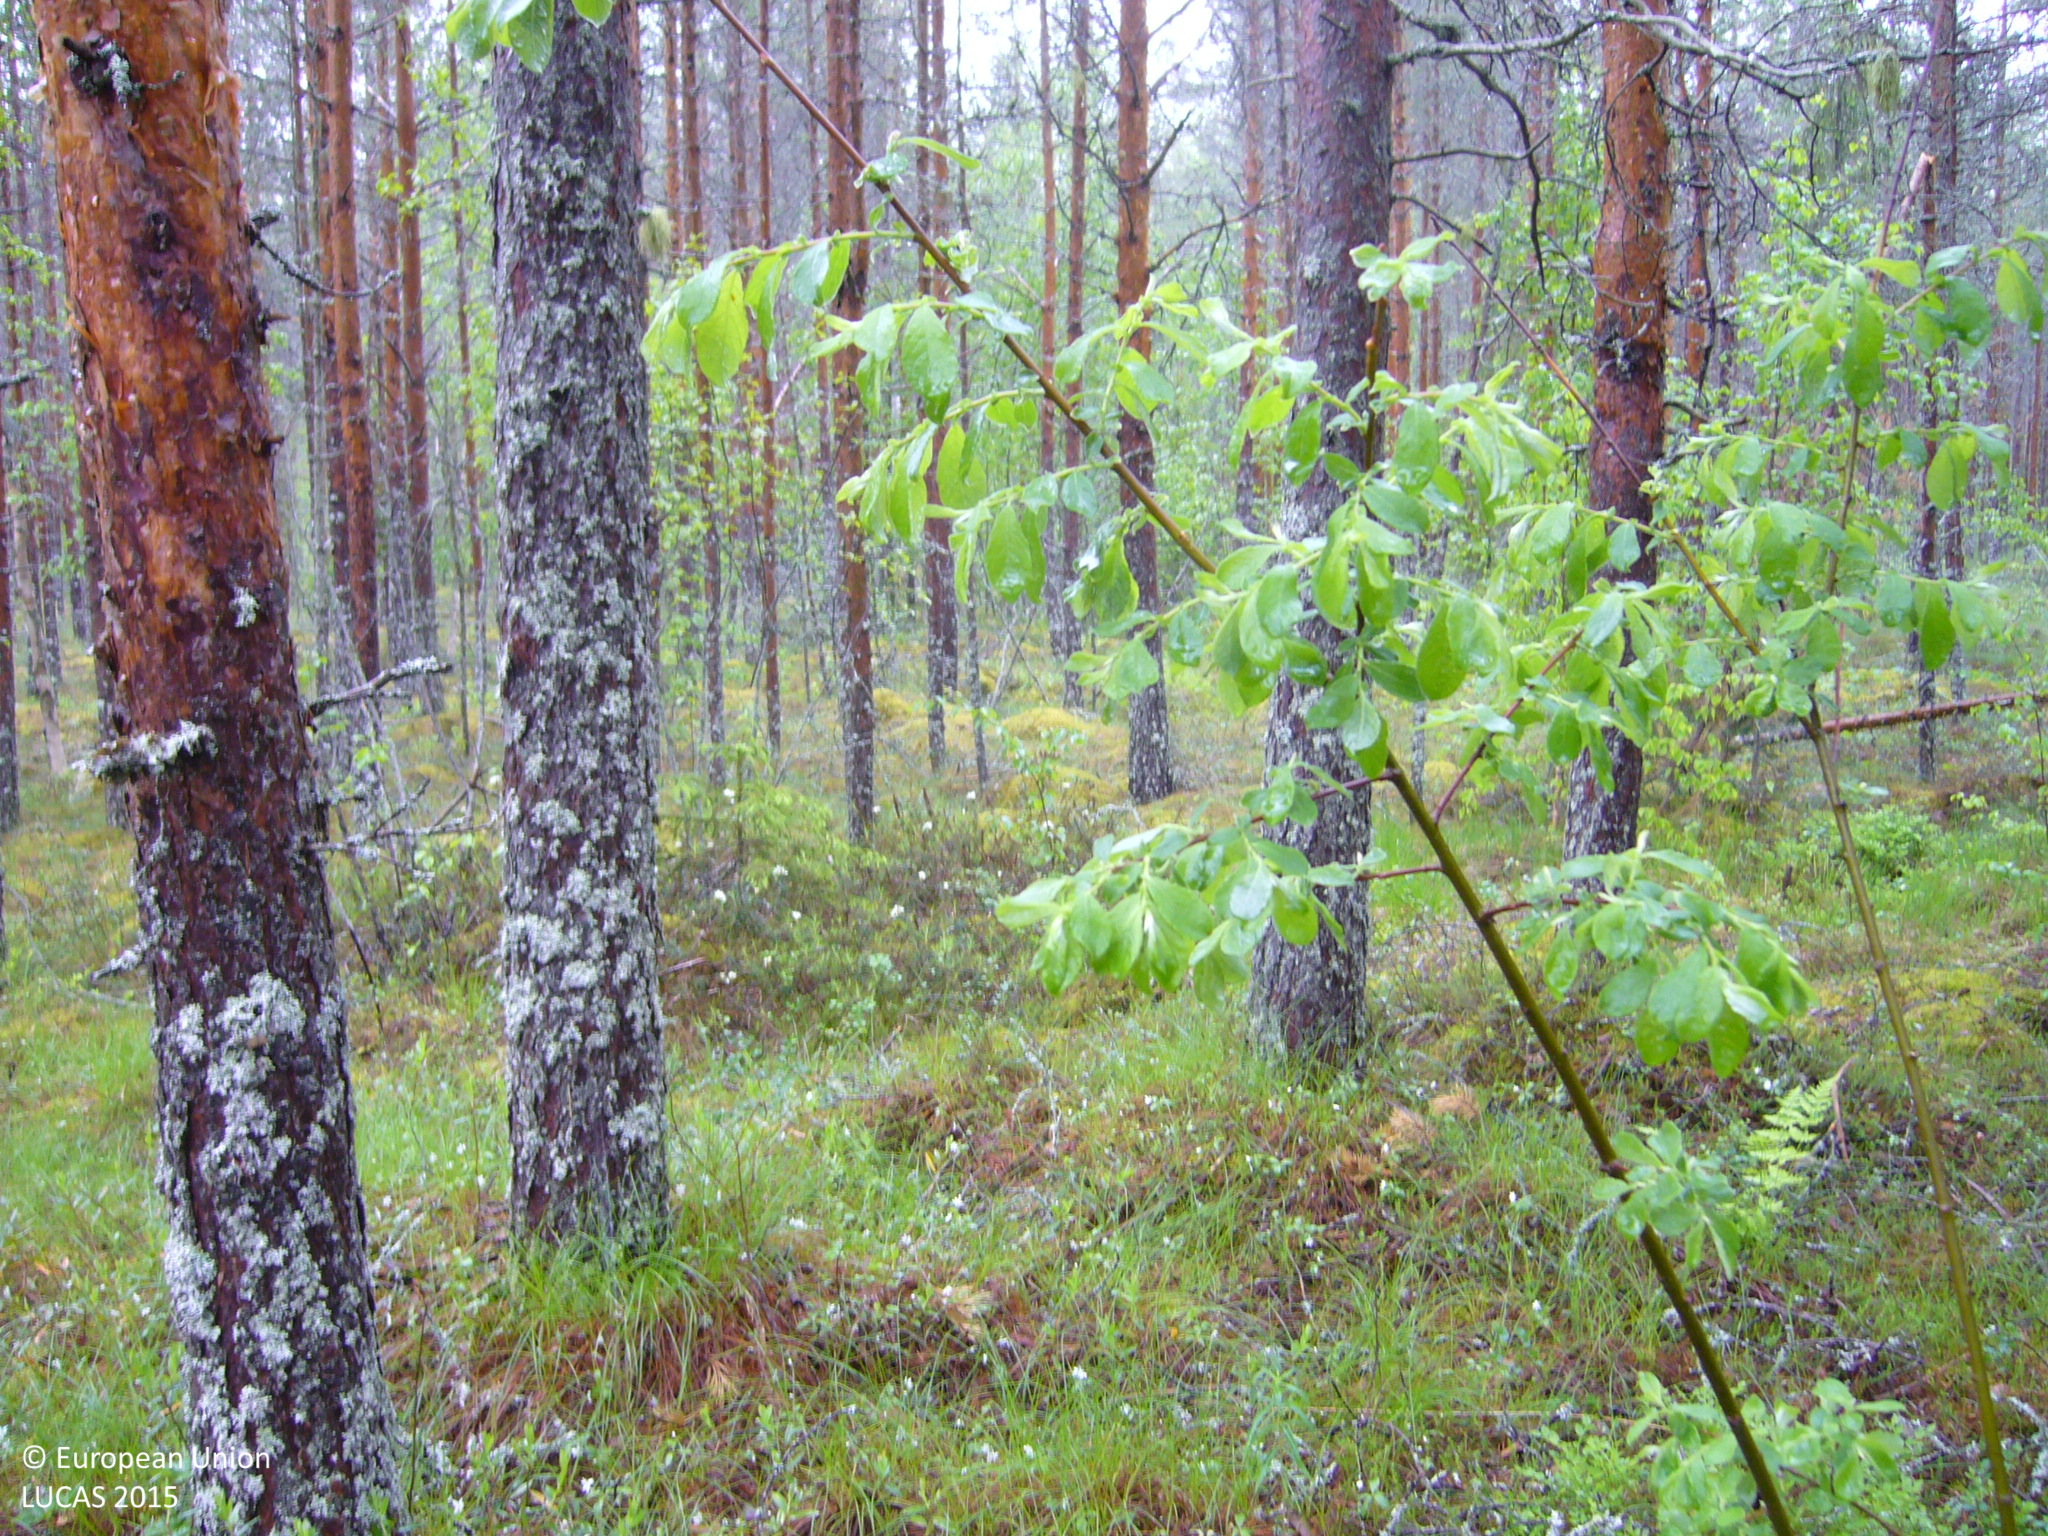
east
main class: Woodland
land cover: Pine dominated coniferous woodland
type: boreal forest
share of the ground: > 75 %
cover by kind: coniferous forest trees 60 %, shrubs 25 %, broadleaved forest trees 15 %
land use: Forestry
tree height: > 5 m
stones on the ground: 10 - 25 %
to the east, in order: Pine dominated coniferous woodland; Ditches and canals; Pine dominated coniferous woodland; Ditches and canals; Pine dominated coniferous woodland; Ditches and canals; Pine dominated coniferous woodland
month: June
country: FI
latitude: 63.7744
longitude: 25.1607
